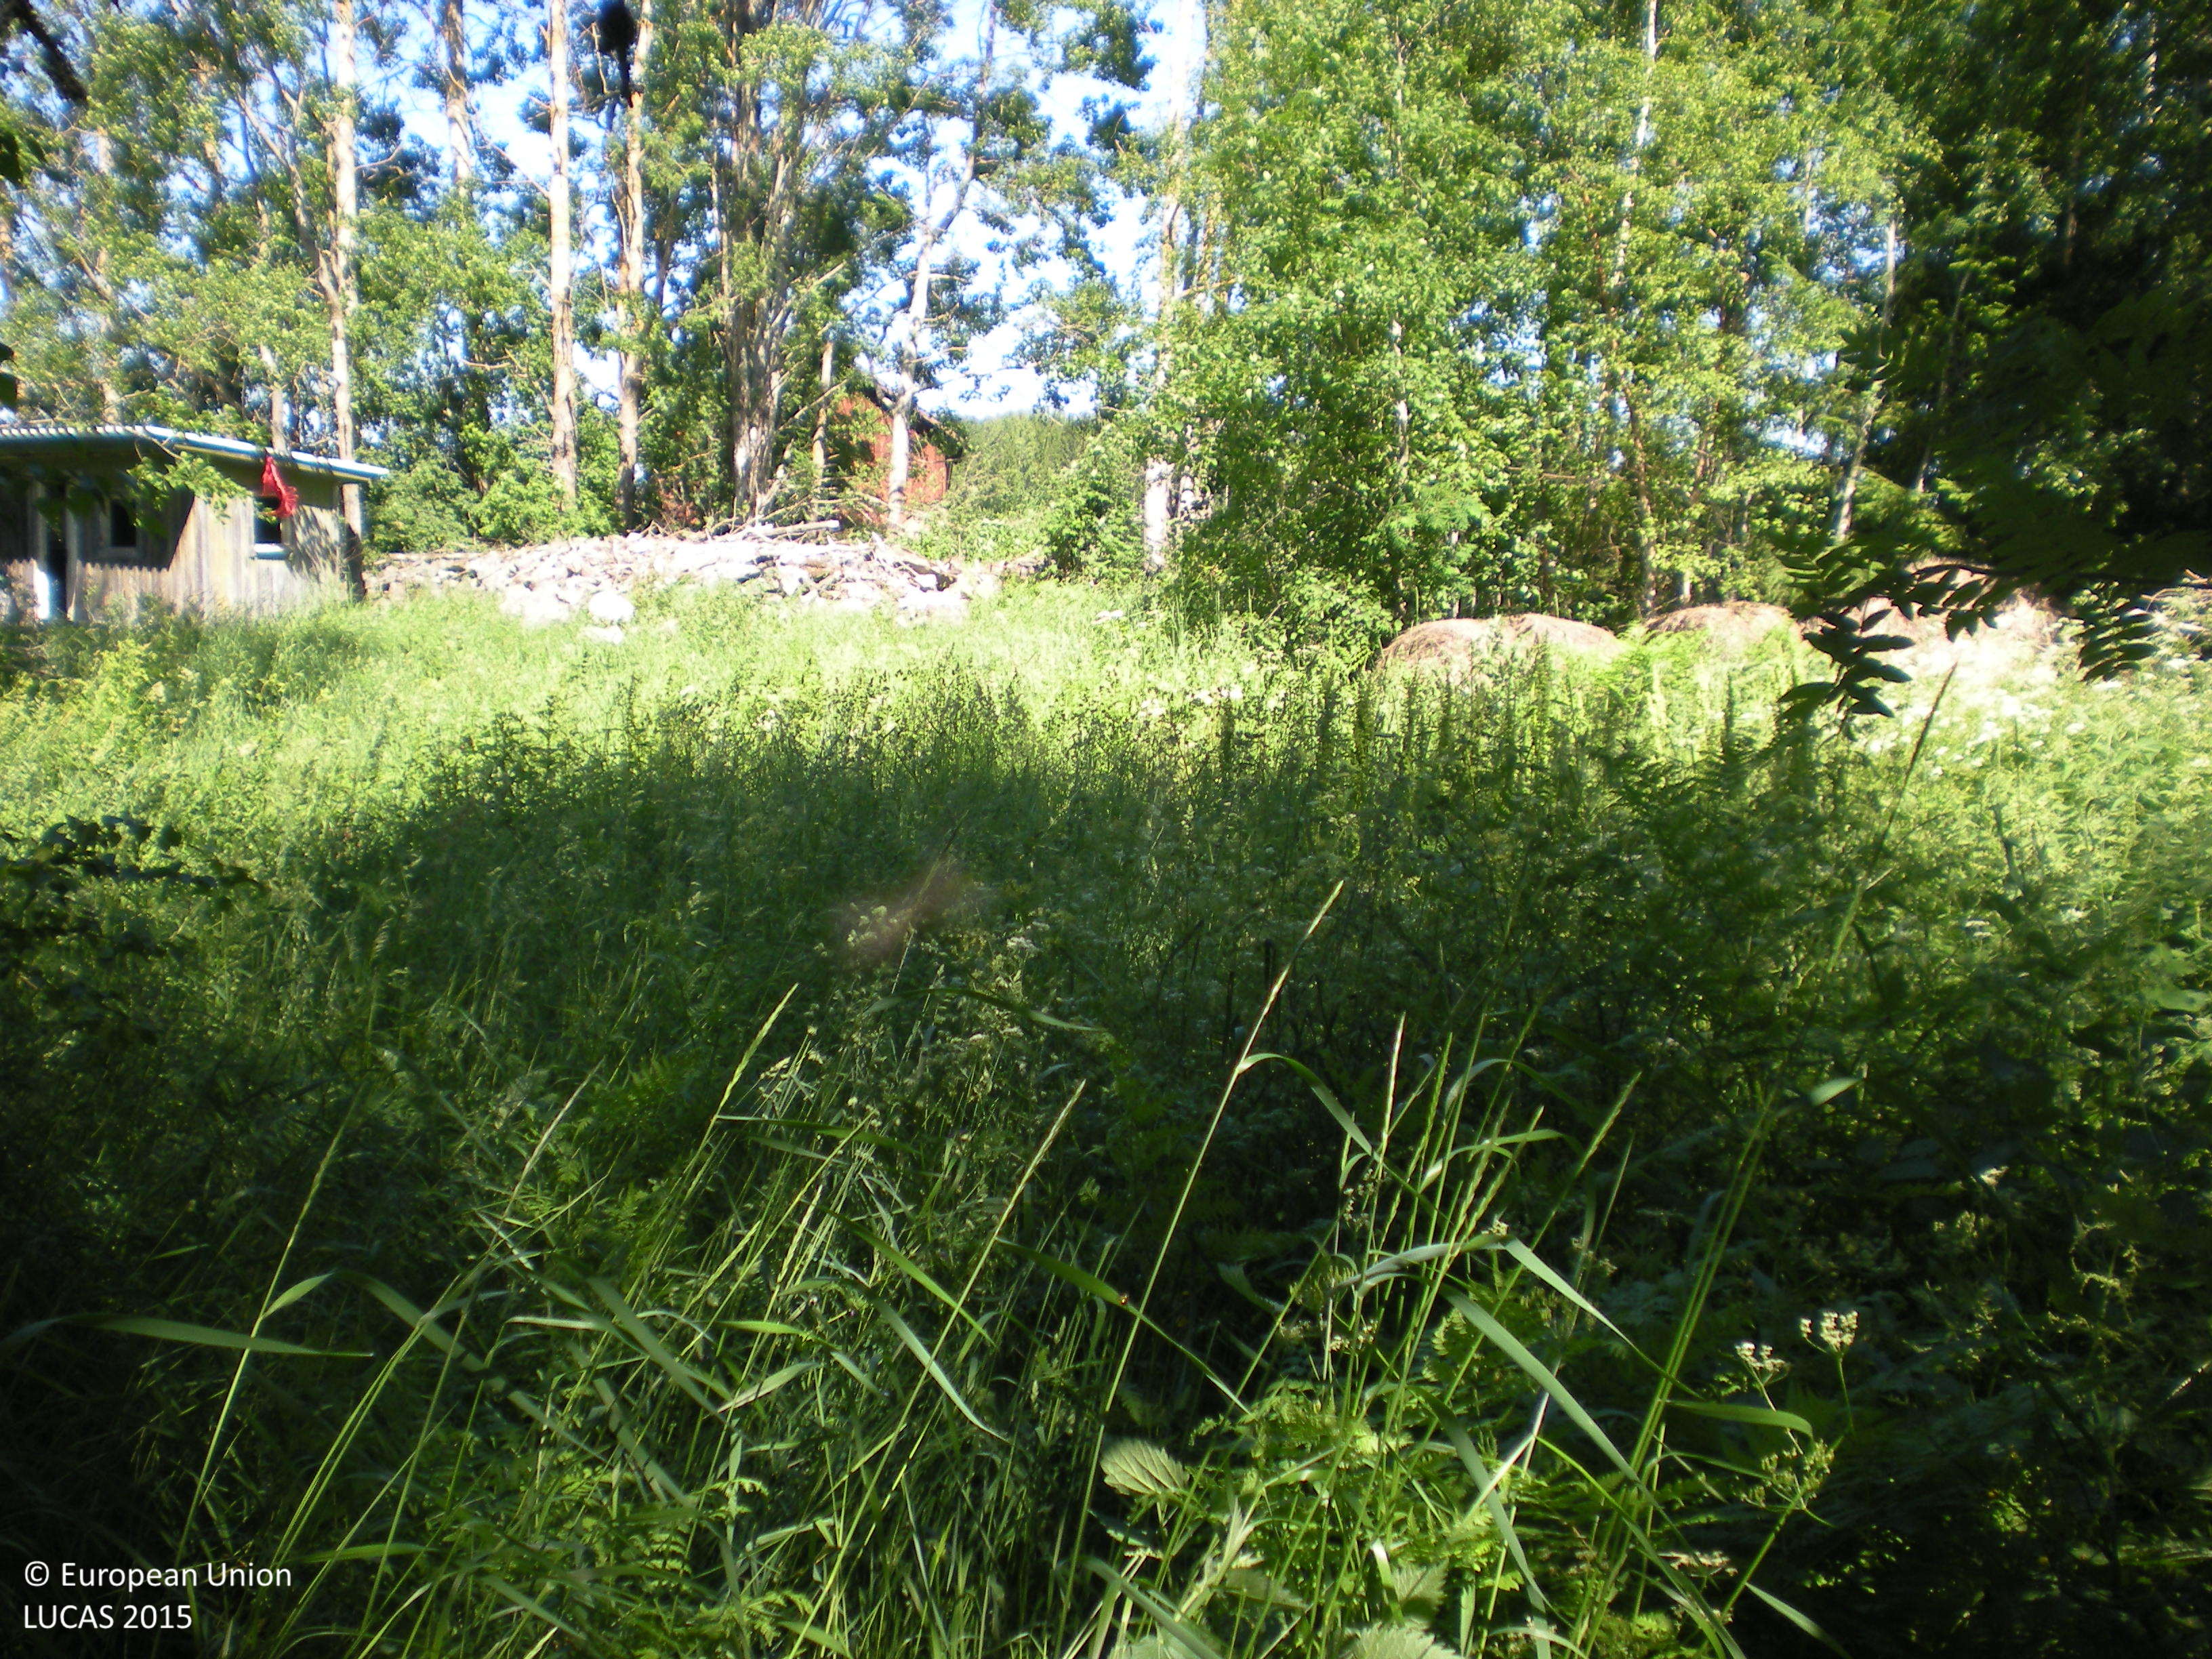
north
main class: Woodland
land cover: Broadleaved woodland
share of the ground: 50 - 75 %
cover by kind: broadleaved forest trees 45 %, herbaceous plants 40 %, shrubs 10 %, coniferous forest trees 5 %
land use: Semi-natural and natural areas not in use
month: July
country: SE
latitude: 60.4559
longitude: 17.7552
